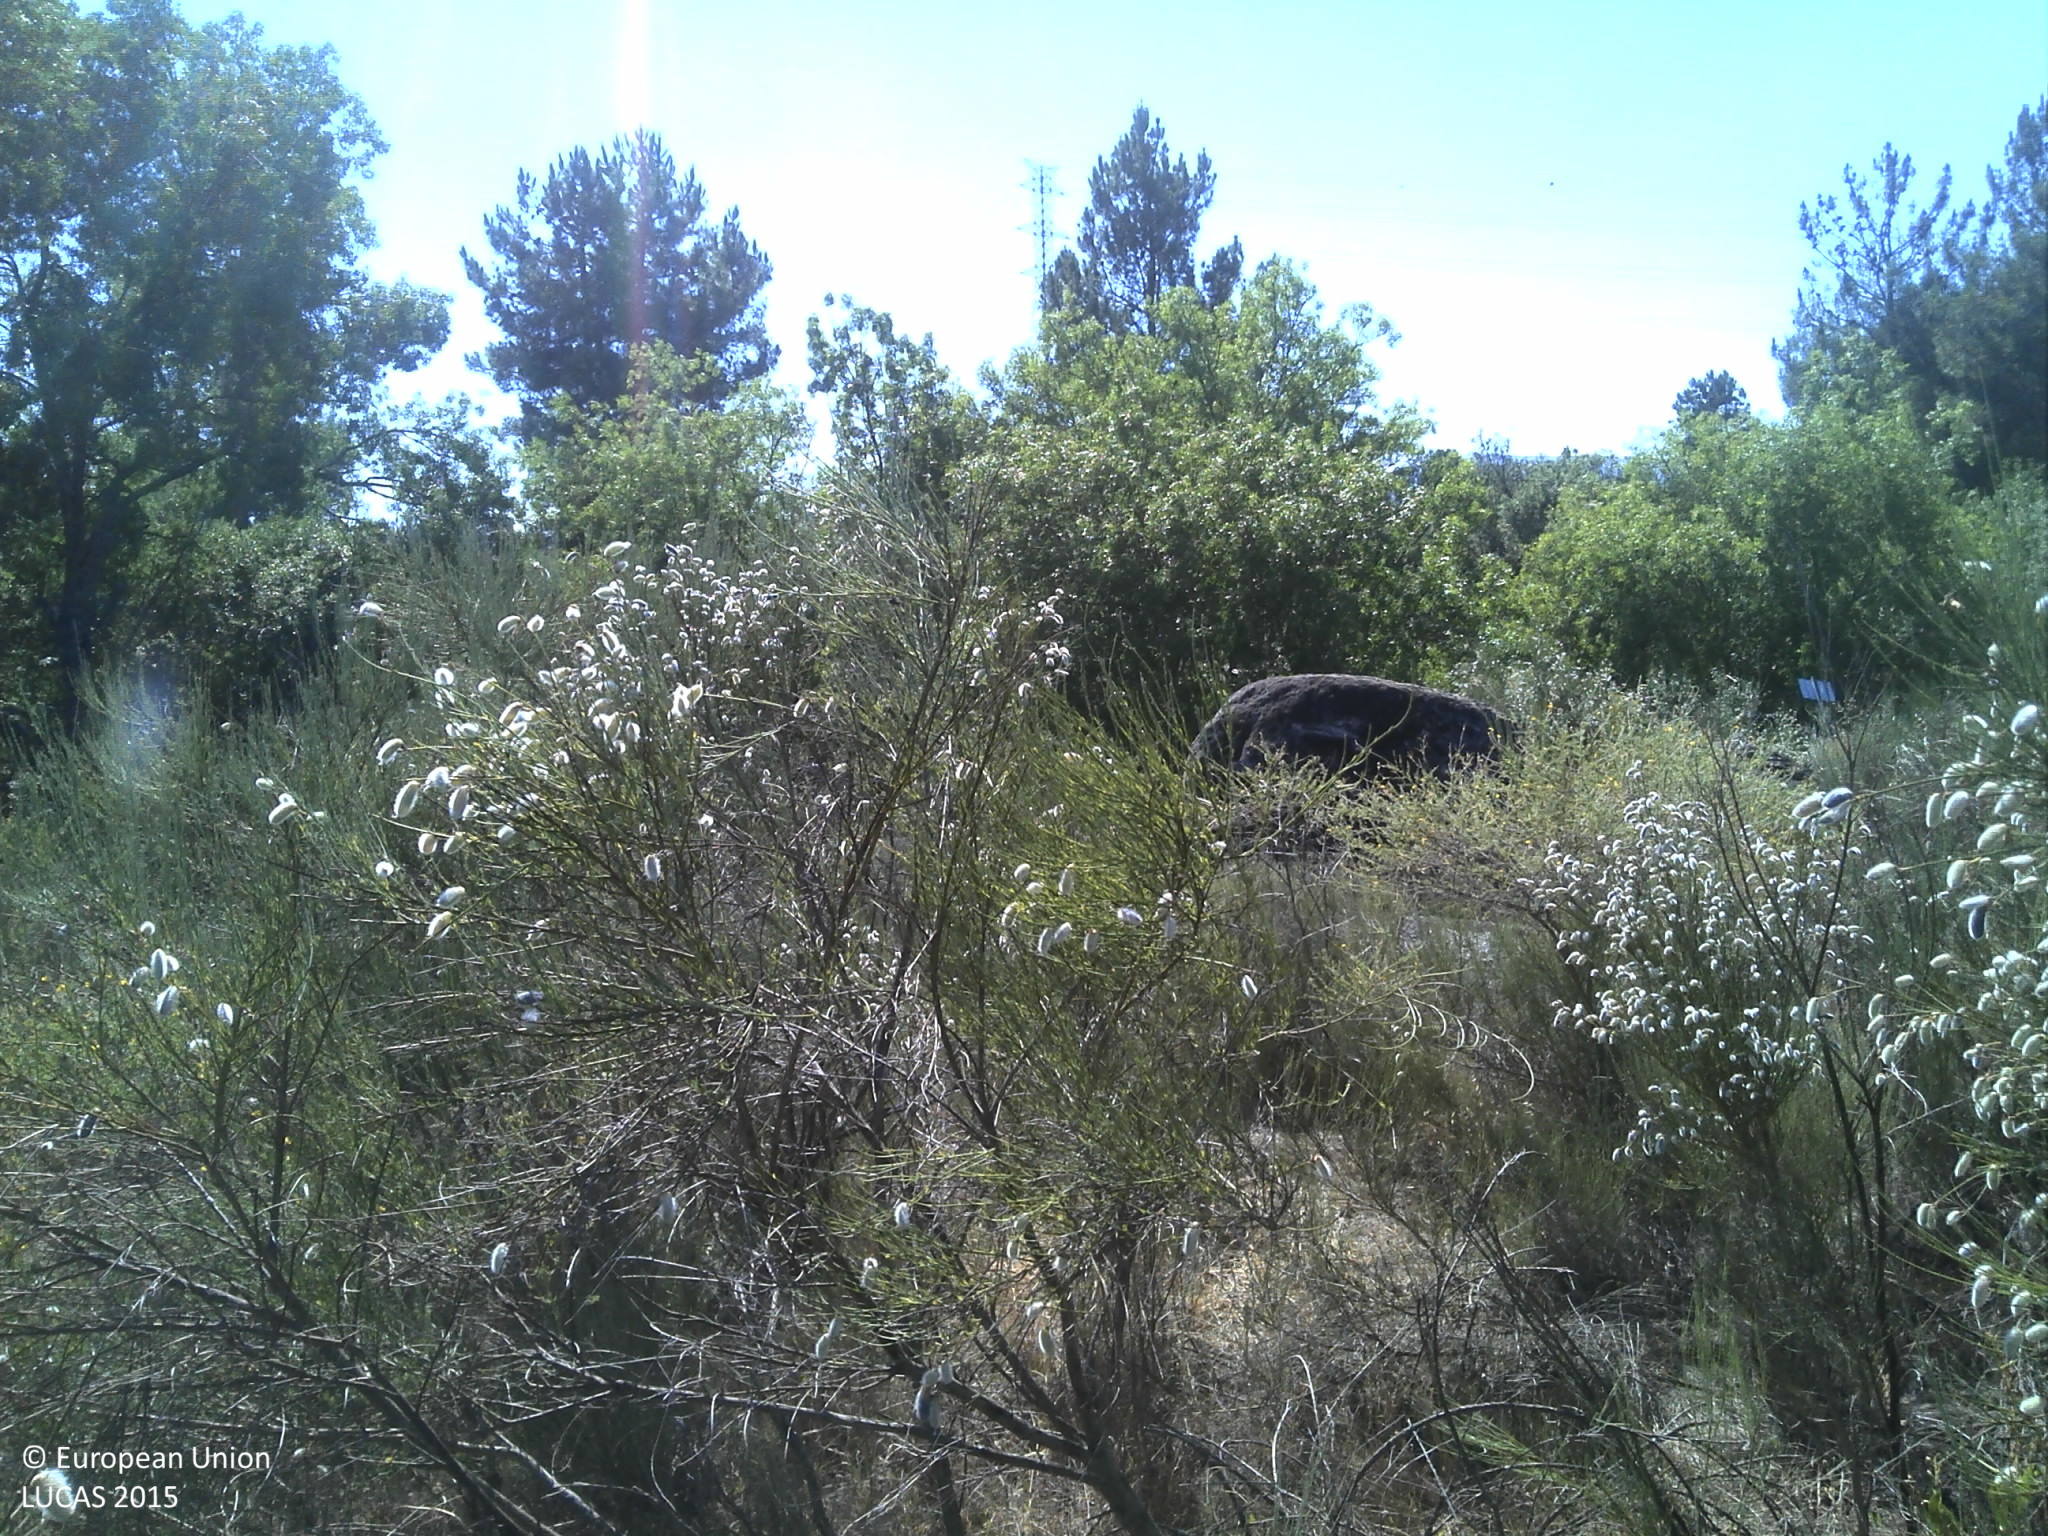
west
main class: Shrubland
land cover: Shrubland without tree cover
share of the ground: 25 - 50 %
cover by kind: shrubs 50 %, consolidated bare surface 30 %, unconsolidated bare surface 20 %
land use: Abandoned areas
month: June
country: PT
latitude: 40.0480
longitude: -7.3897
